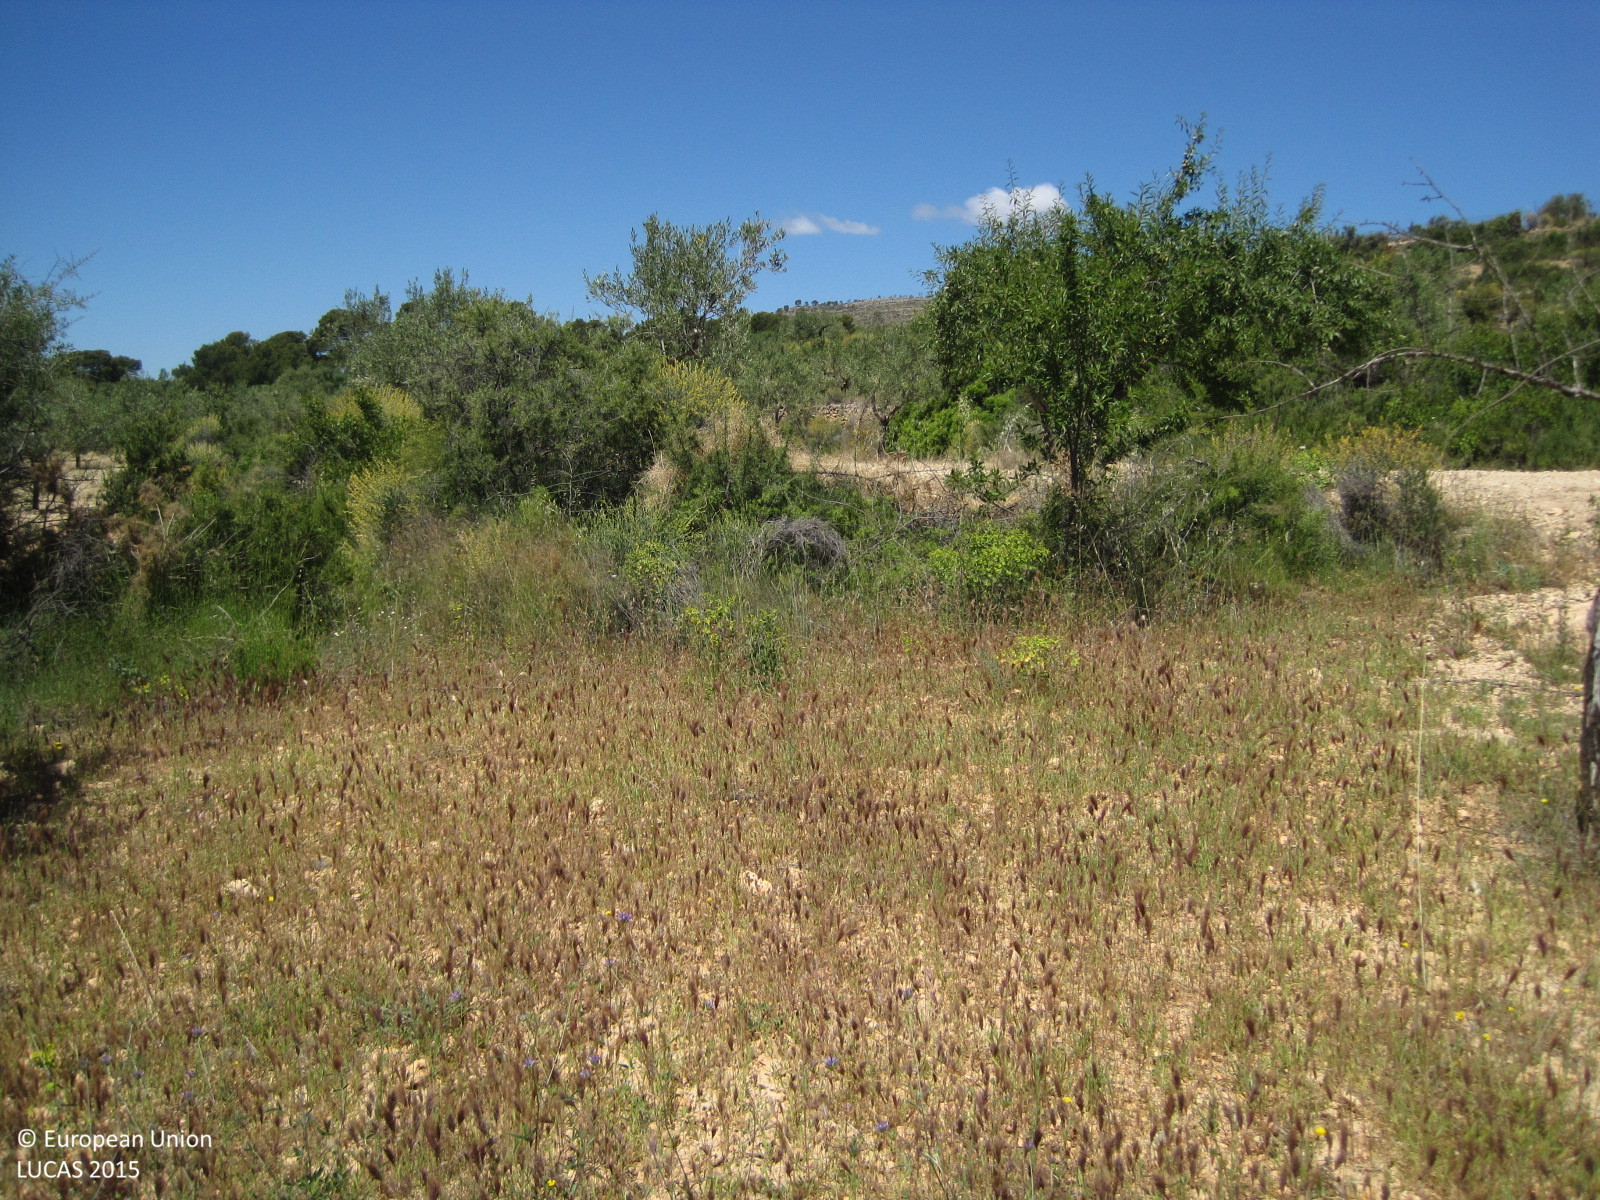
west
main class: Cropland
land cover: Nuts trees
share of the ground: 10 - 25 %
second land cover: Spontaneously vegetated surfaces
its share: > 75 %
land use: Agriculture (excluding fallow land and kitchen gardens)
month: May
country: ES
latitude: 39.7503
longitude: -0.7275
